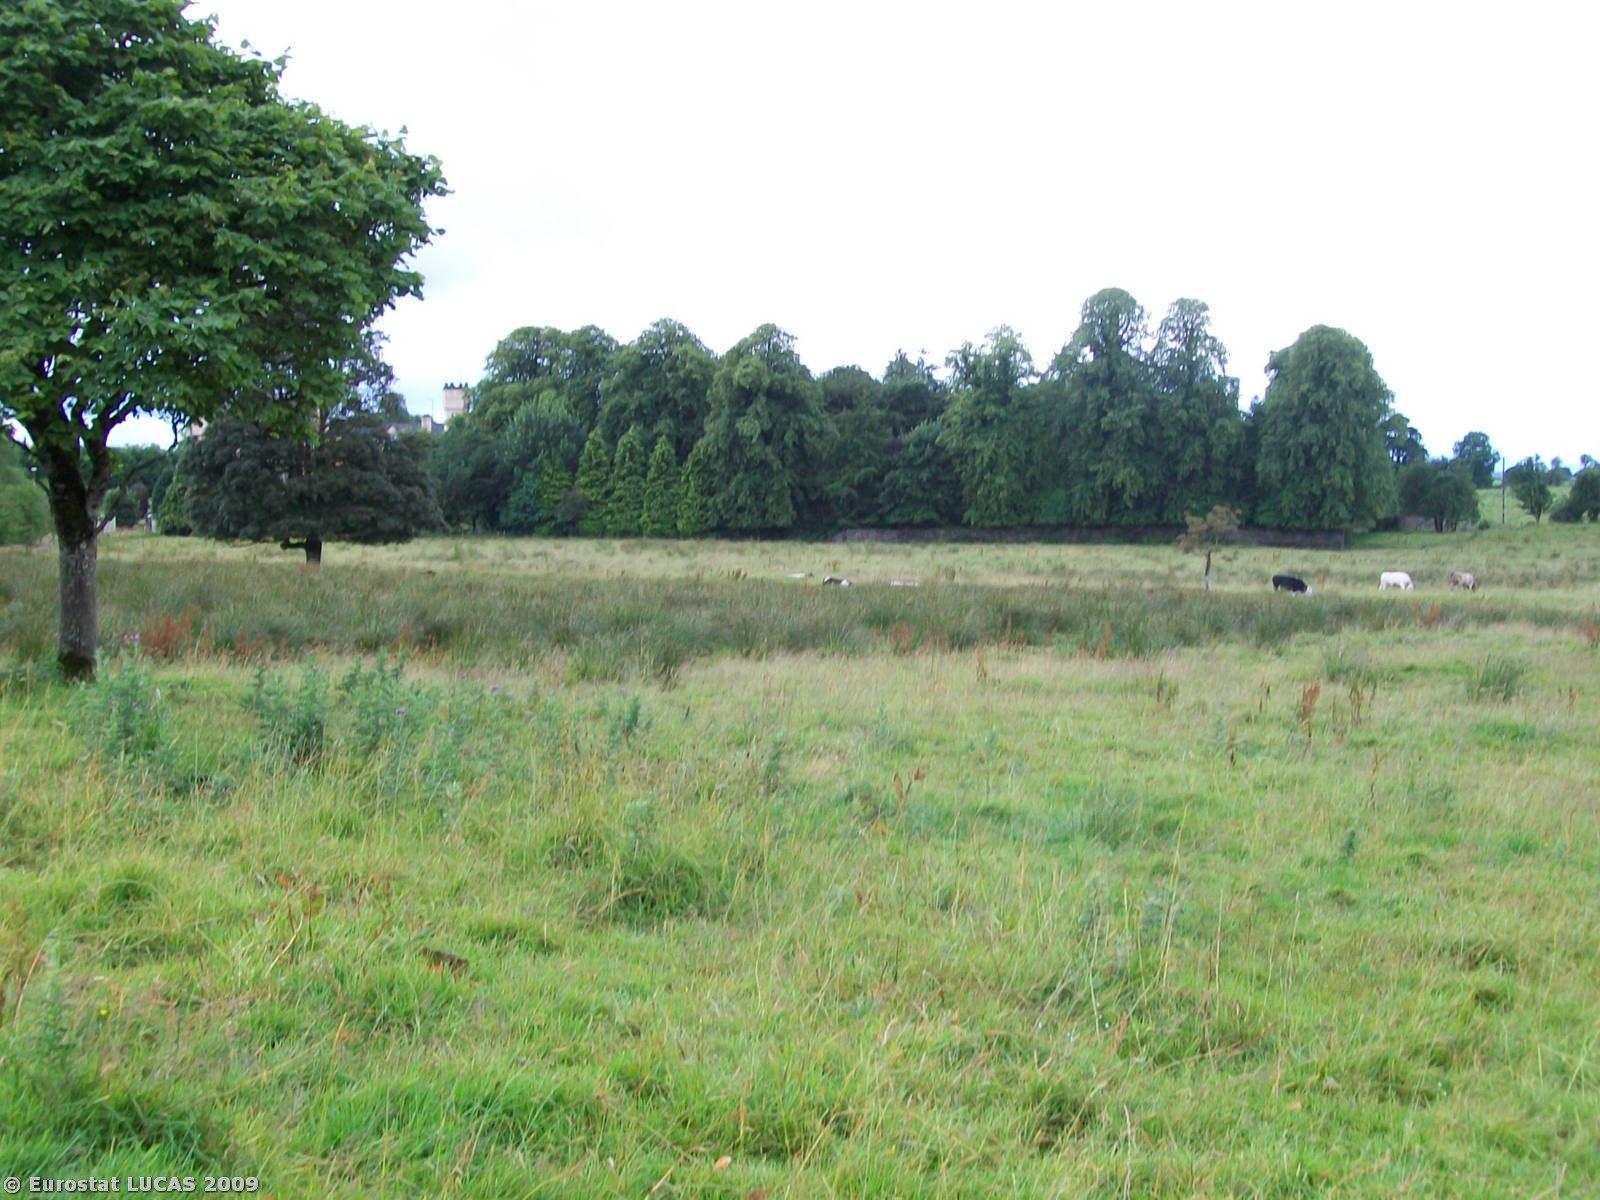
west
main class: Grassland
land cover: Grassland without tree/shrub cover
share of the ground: > 75 %
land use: Agriculture (excluding fallow land and kitchen gardens)
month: July
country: IE
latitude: 53.6945
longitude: -8.9757
